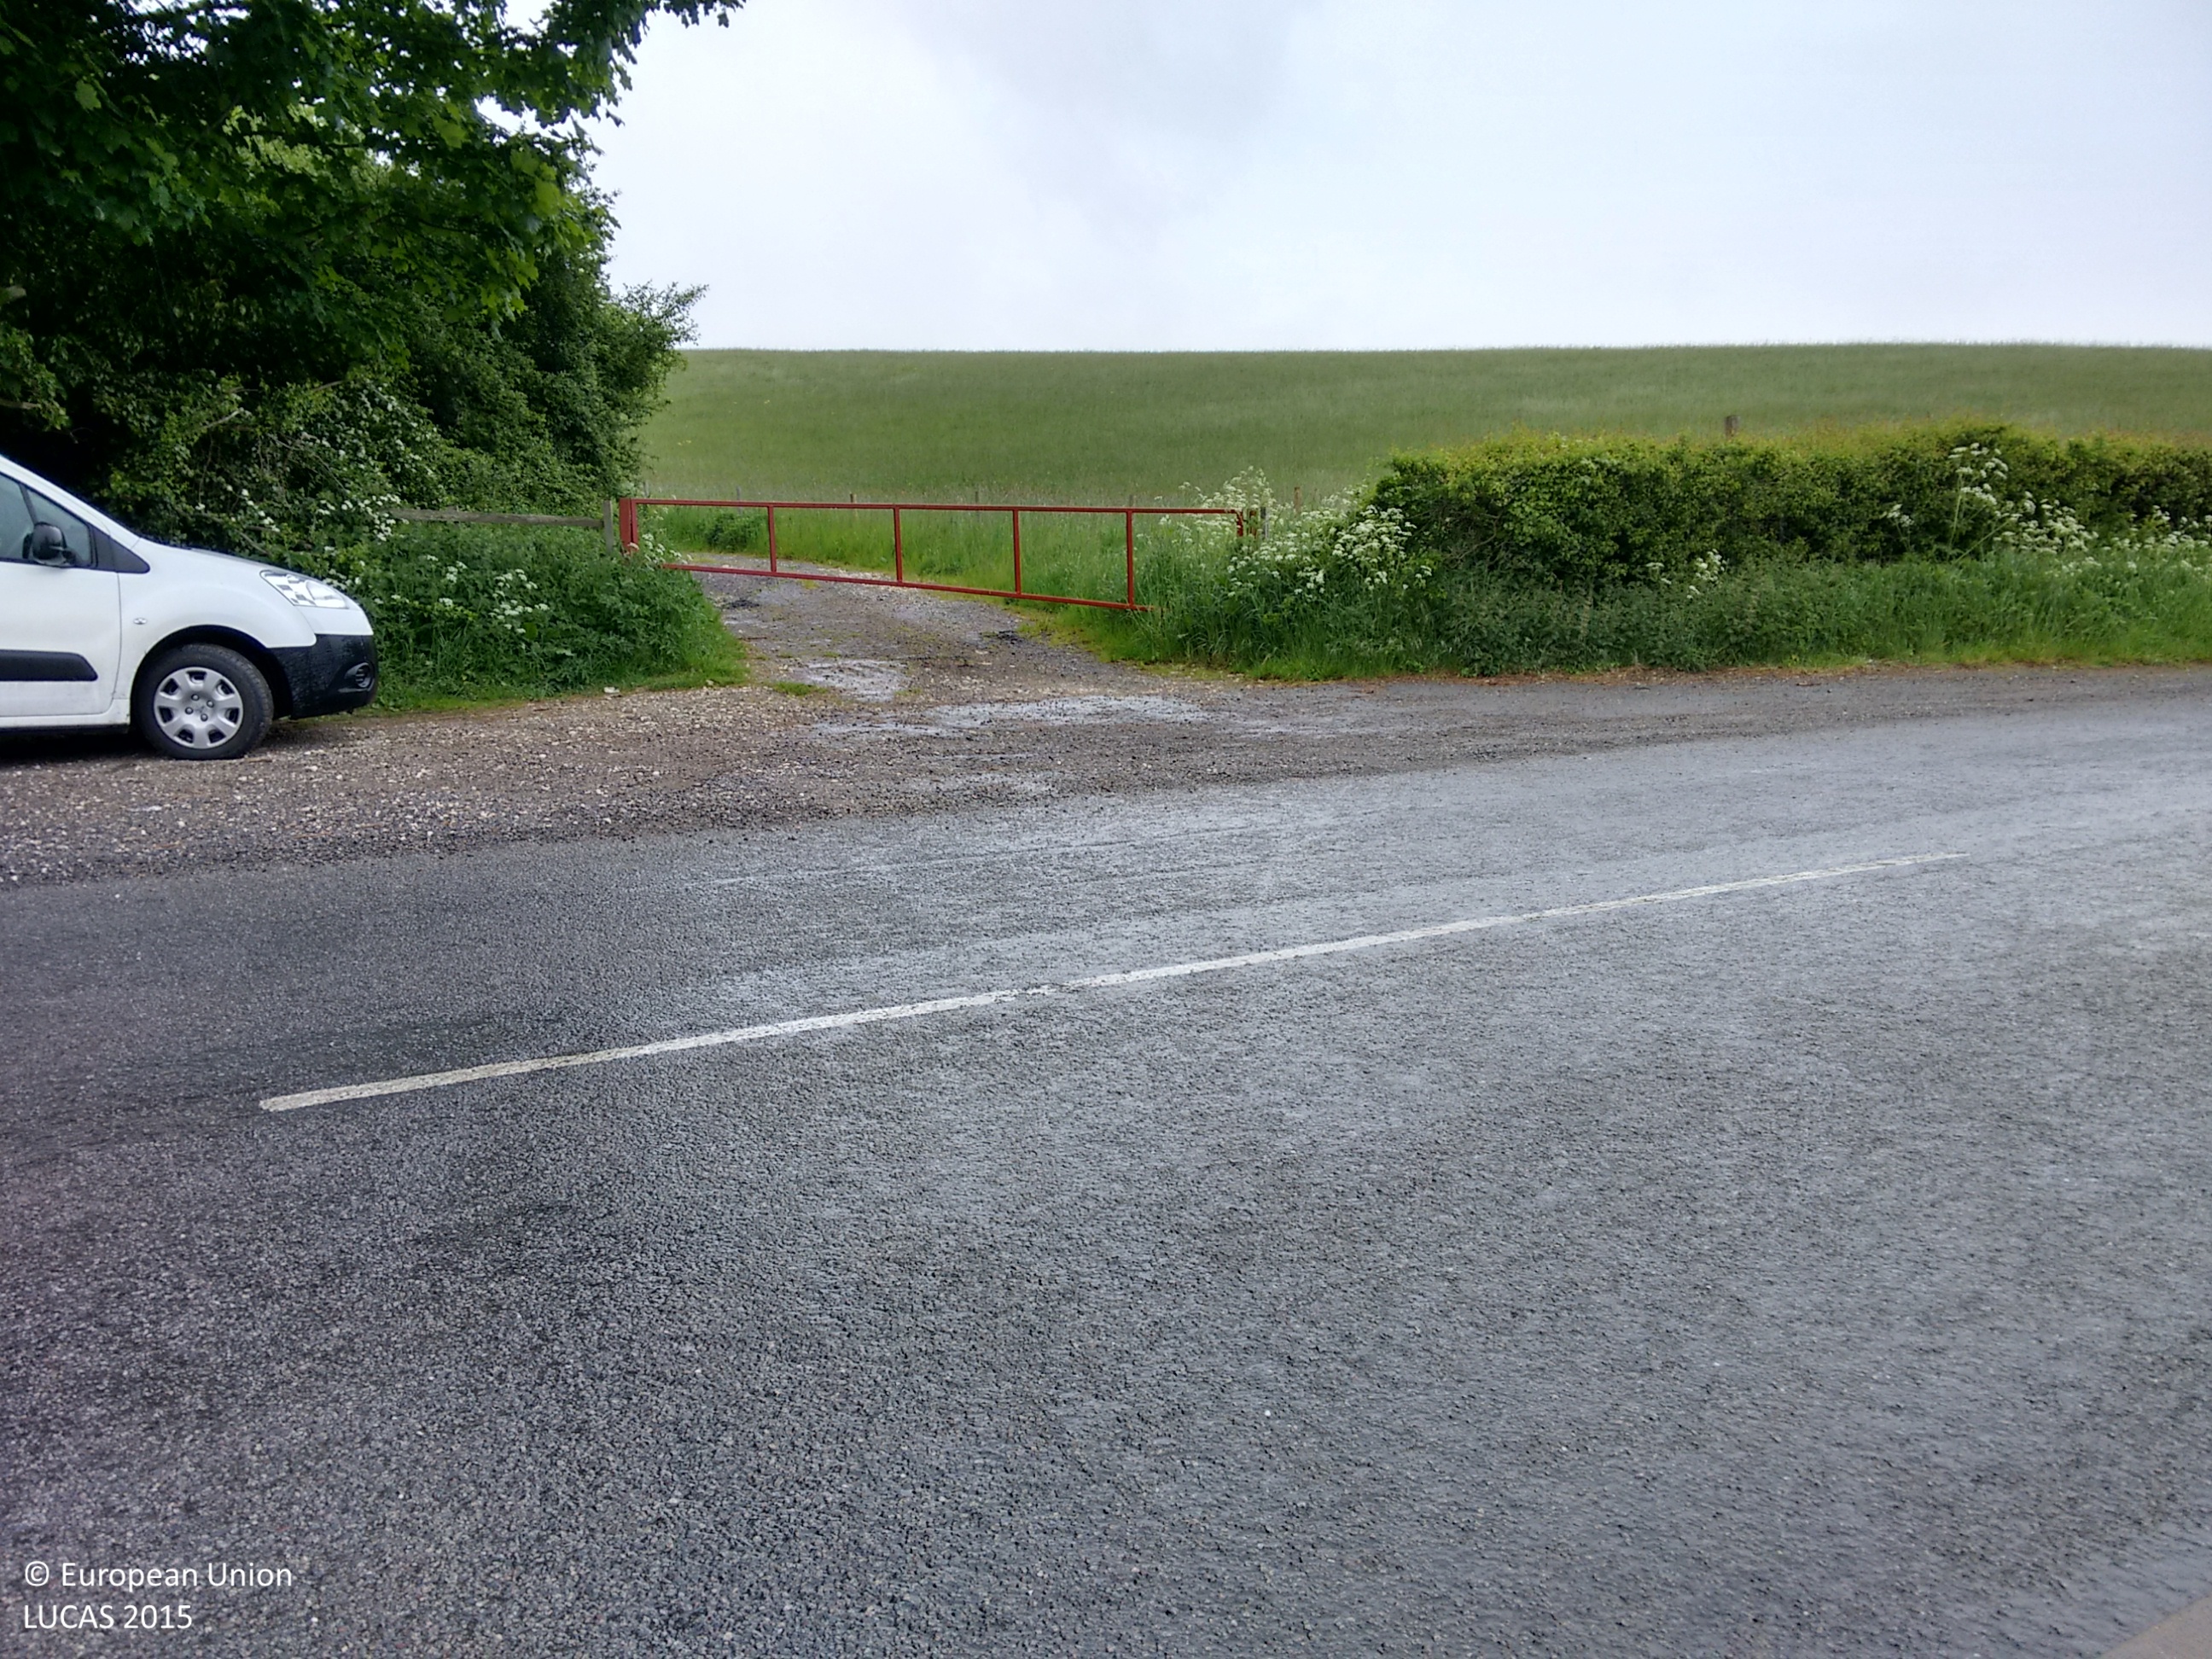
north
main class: Cropland
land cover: Arable land (only in case pi)
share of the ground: > 75 %
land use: Agriculture (excluding fallow land and kitchen gardens)
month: May
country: GB
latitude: 53.4012
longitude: -0.2470
